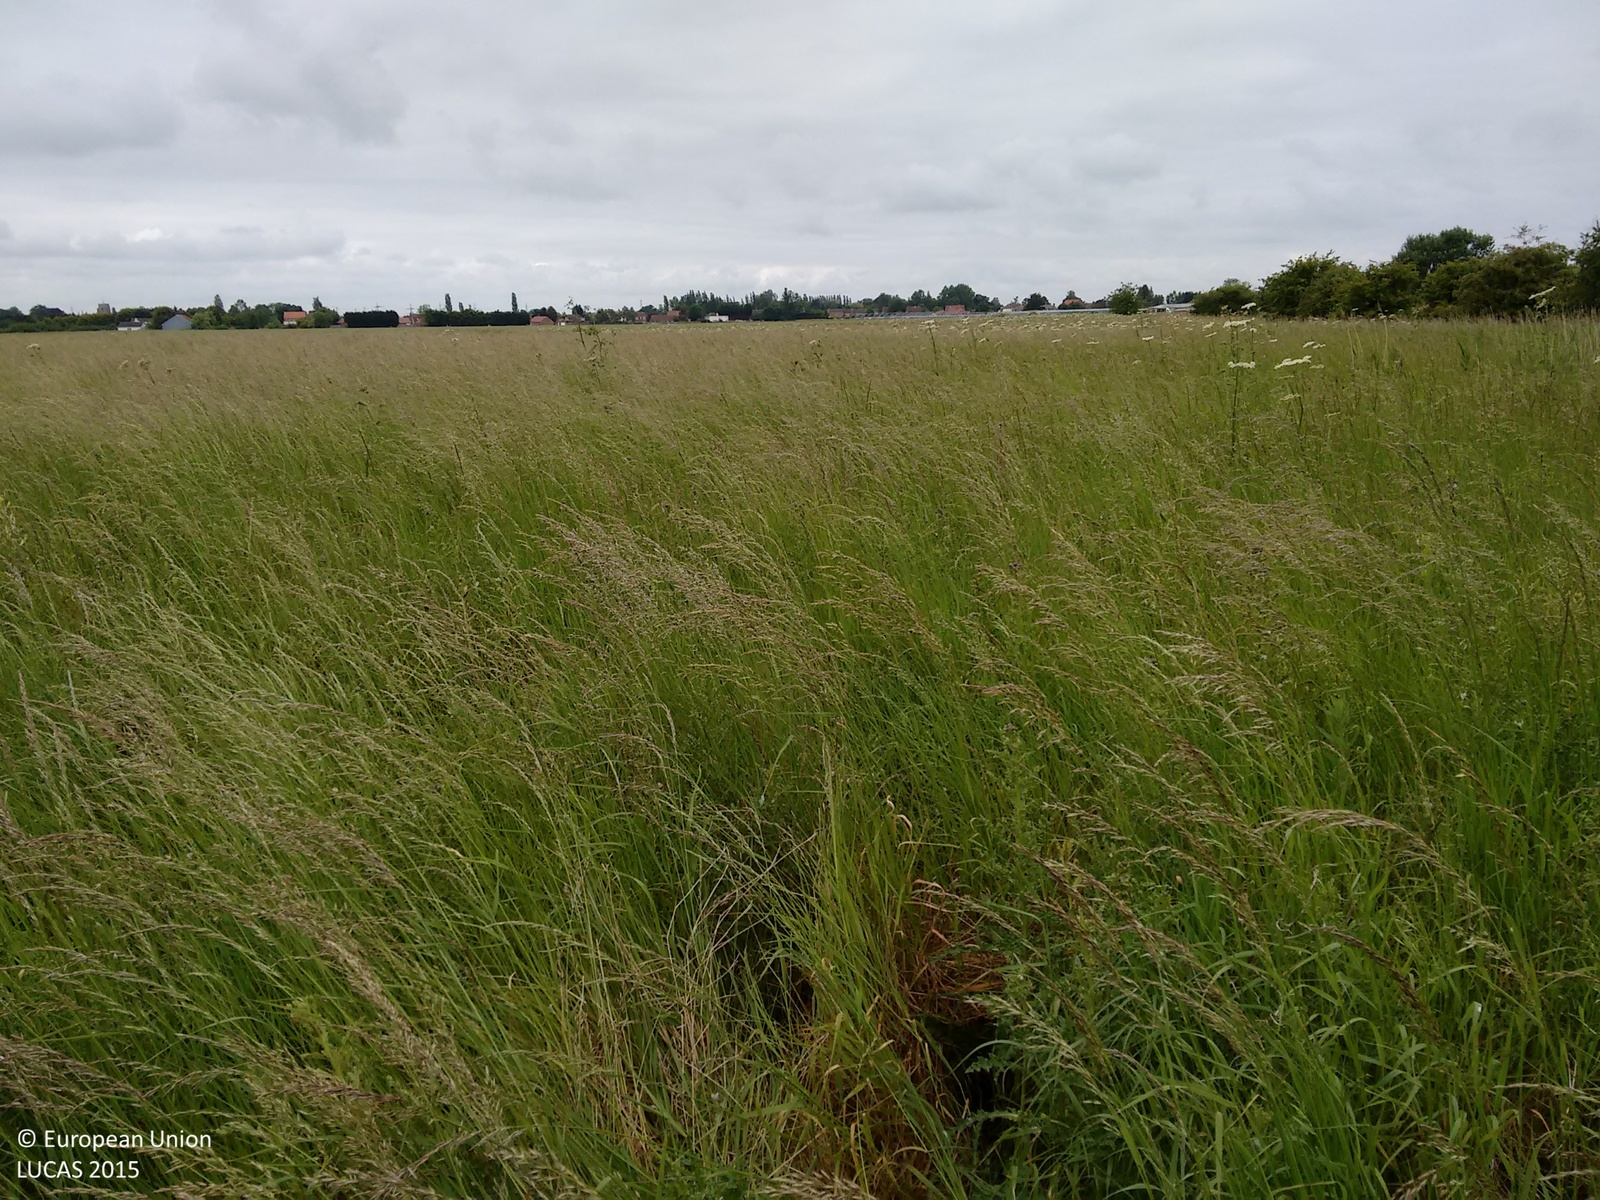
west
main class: Grassland
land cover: Grassland without tree/shrub cover
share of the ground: > 75 %
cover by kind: herbaceous plants 100 %
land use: Sport
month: June
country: GB
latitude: 52.7351
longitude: 0.2399
